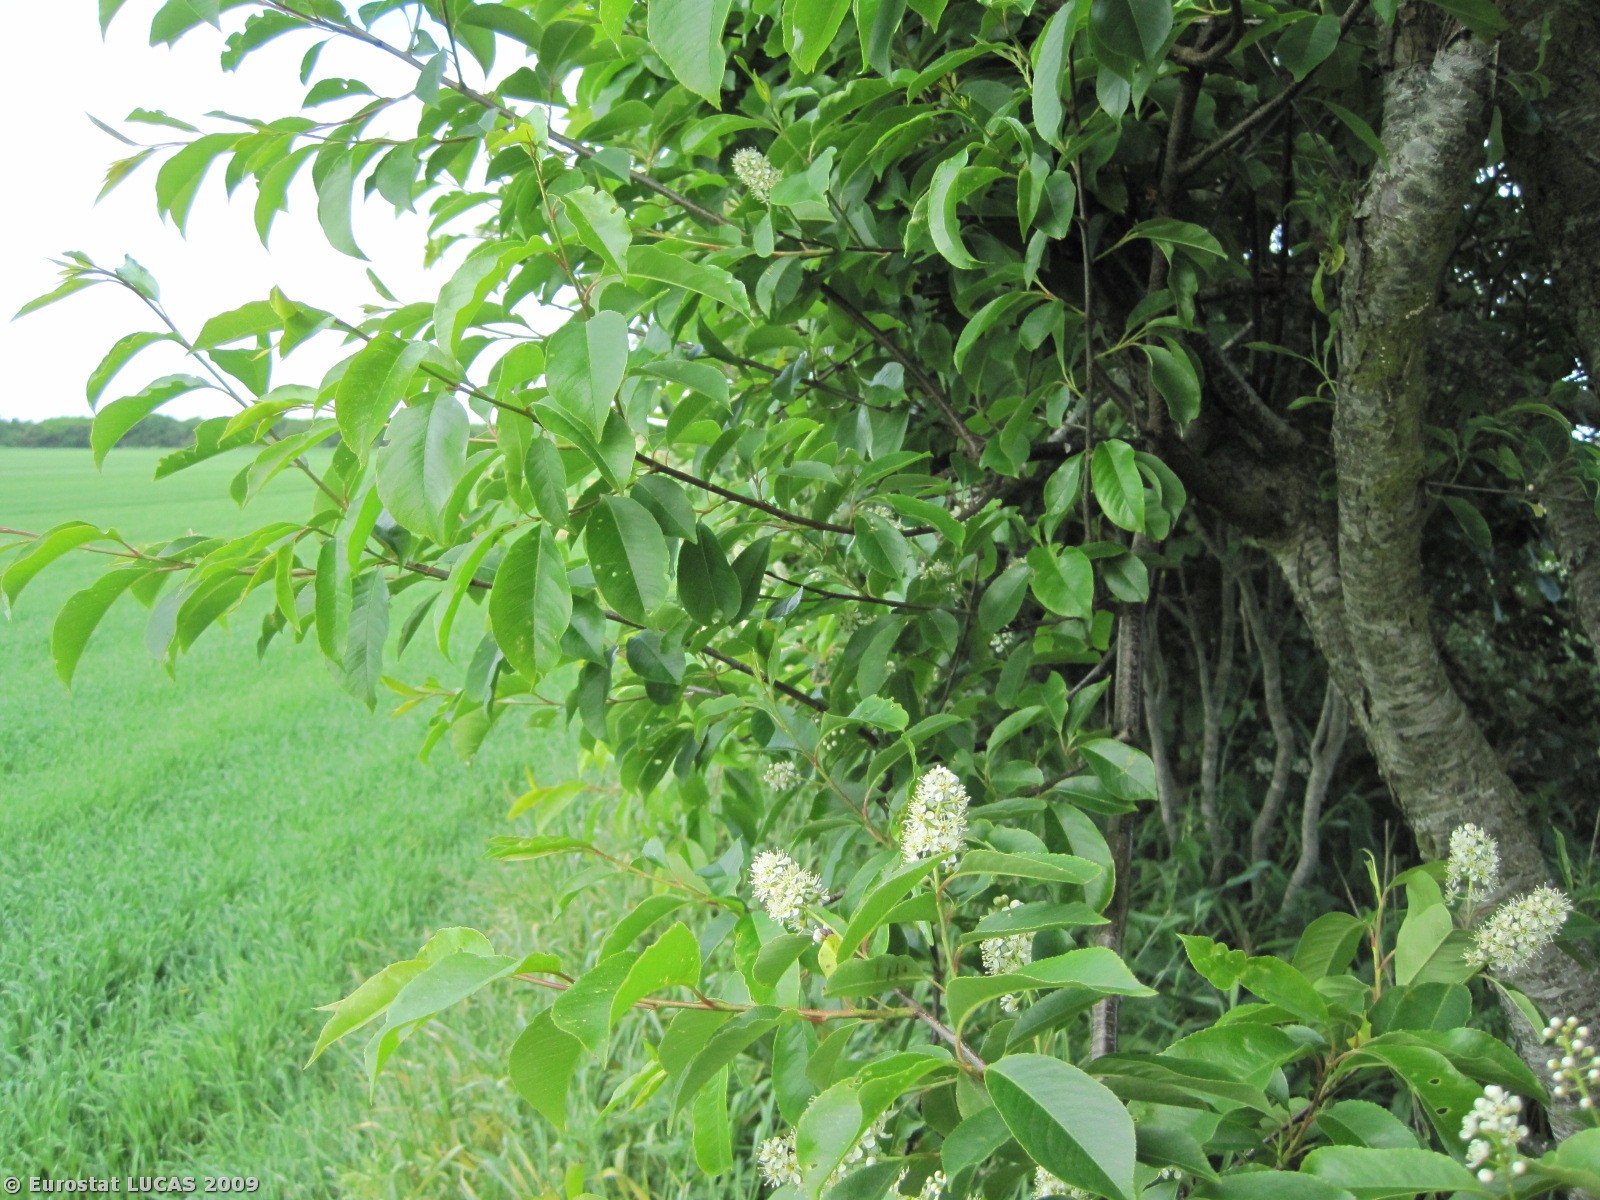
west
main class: Woodland
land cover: Broadleaved woodland
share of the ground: > 75 %
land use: Agriculture (excluding fallow land and kitchen gardens)
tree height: > 5 m
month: June
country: DK
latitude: 57.1943
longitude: 9.7852
